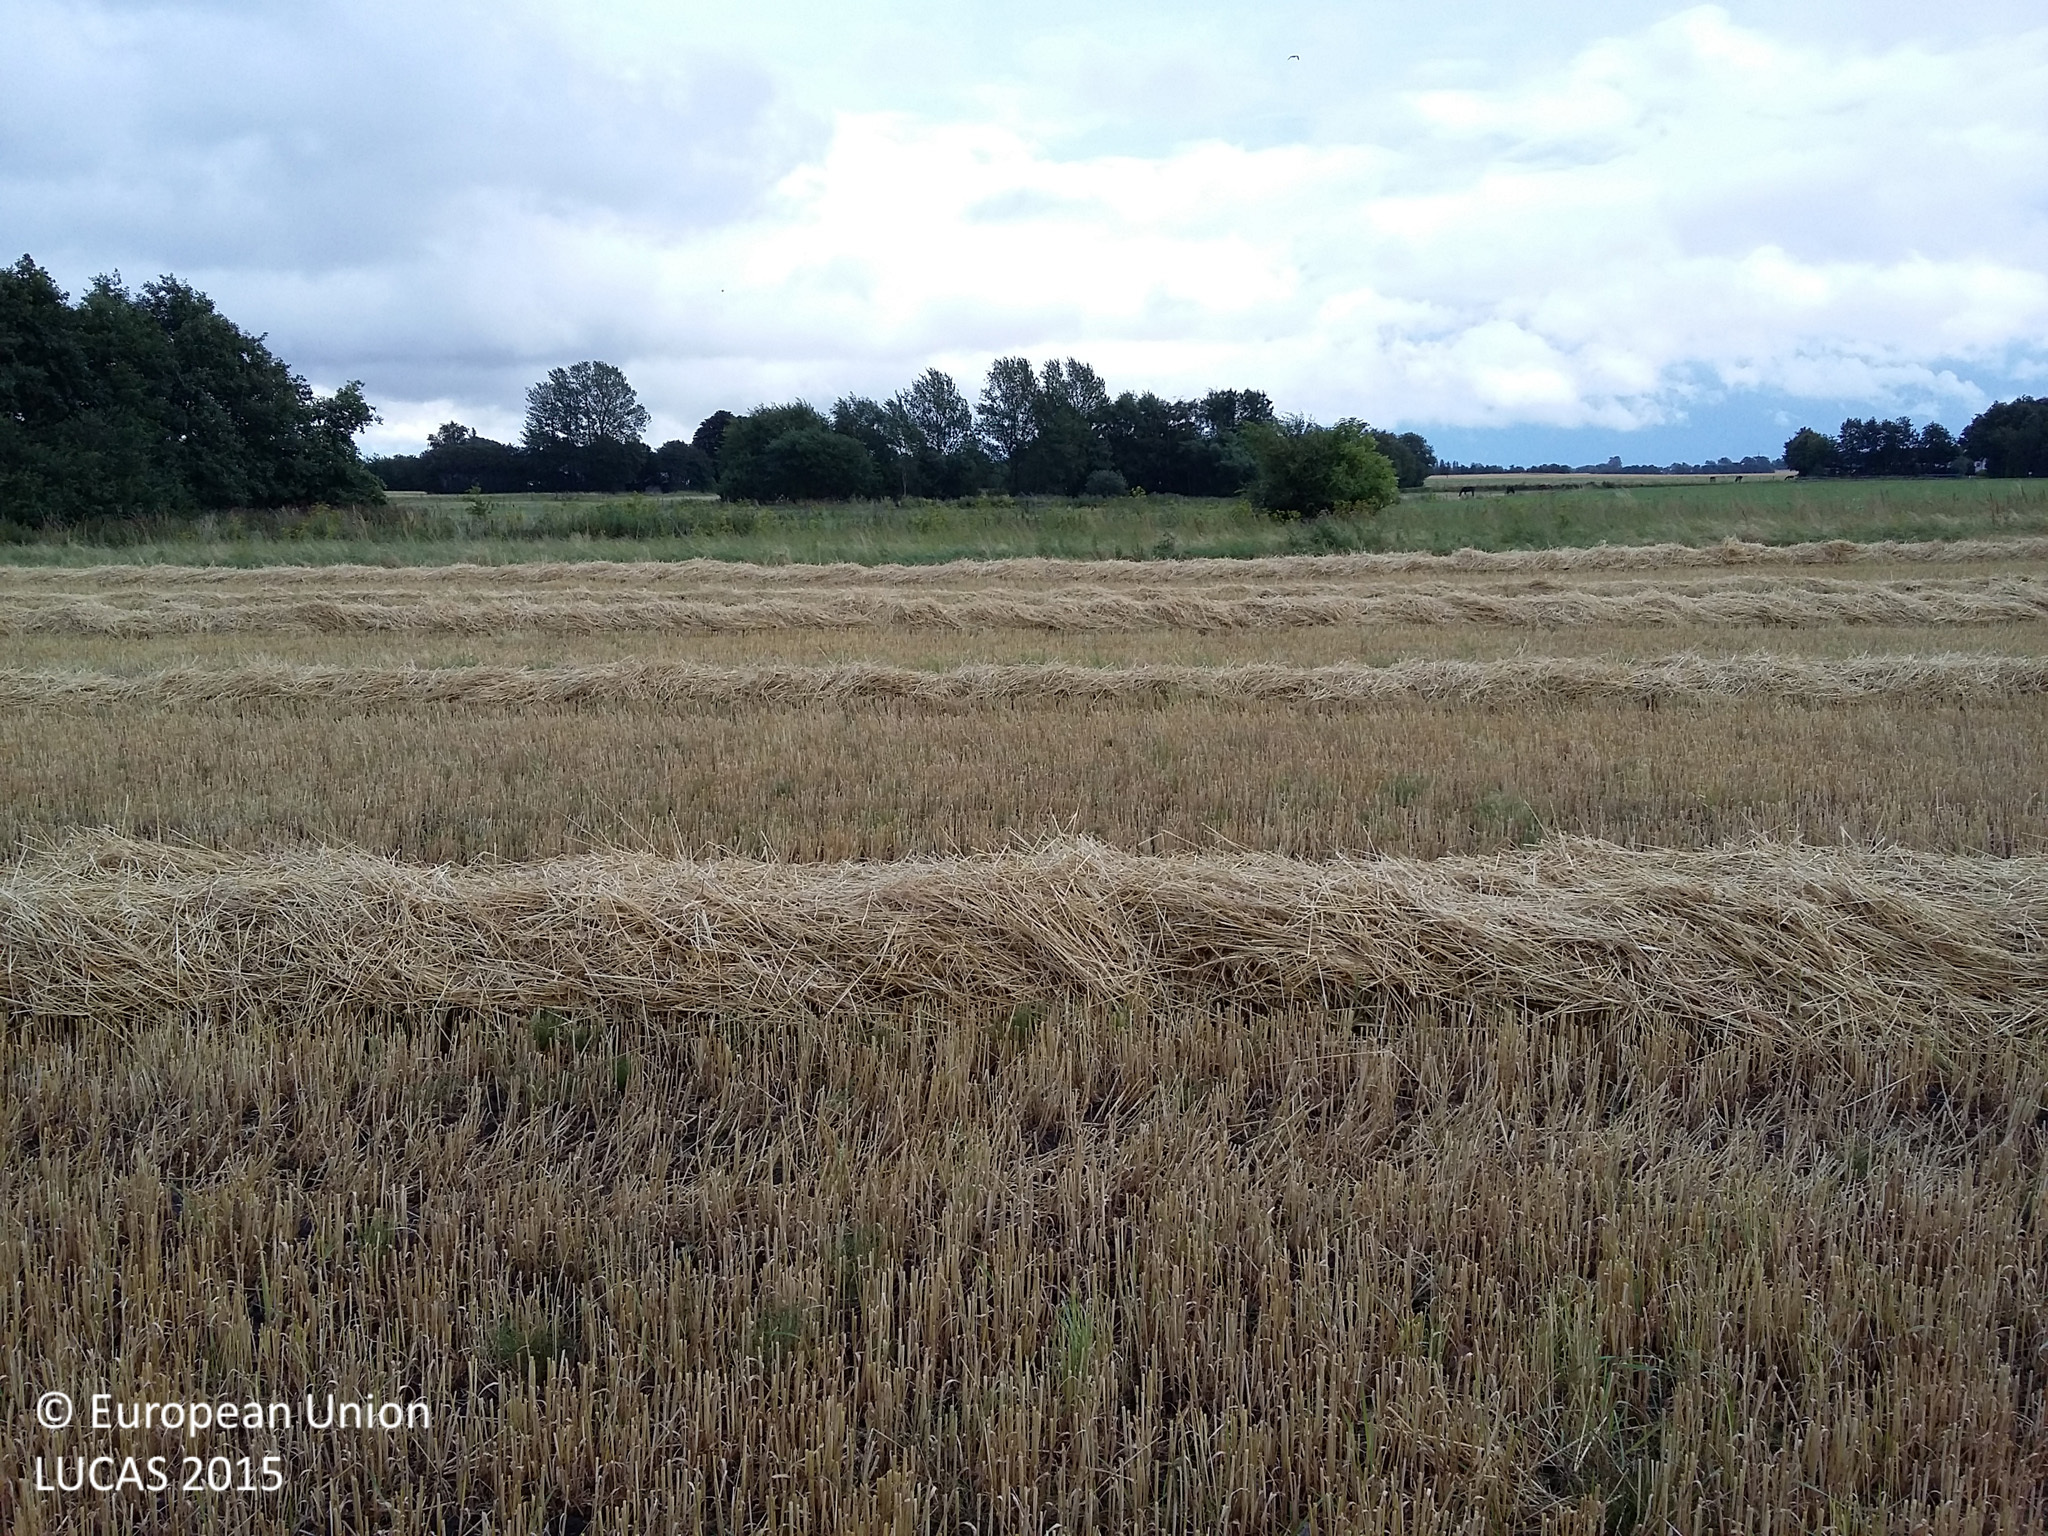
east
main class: Cropland
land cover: Barley
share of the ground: > 75 %
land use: Agriculture (excluding fallow land and kitchen gardens)
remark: Harvested field
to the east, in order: Barley; Grassland without tree/shrub cover; Ditches and canals; Shruby margins; Temporary grasslands; Shruby margins; Fences; Shruby margins; Grassland without tree/shrub cover; Shruby margins; Fences; Shruby margins; Inland fresh water bodies; Grassland without tree/shrub cover; Ditches and canals; Broadleaved woodland; Fences; Grassland without tree/shrub cover
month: July
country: DK
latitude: 55.8830
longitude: 12.0923
